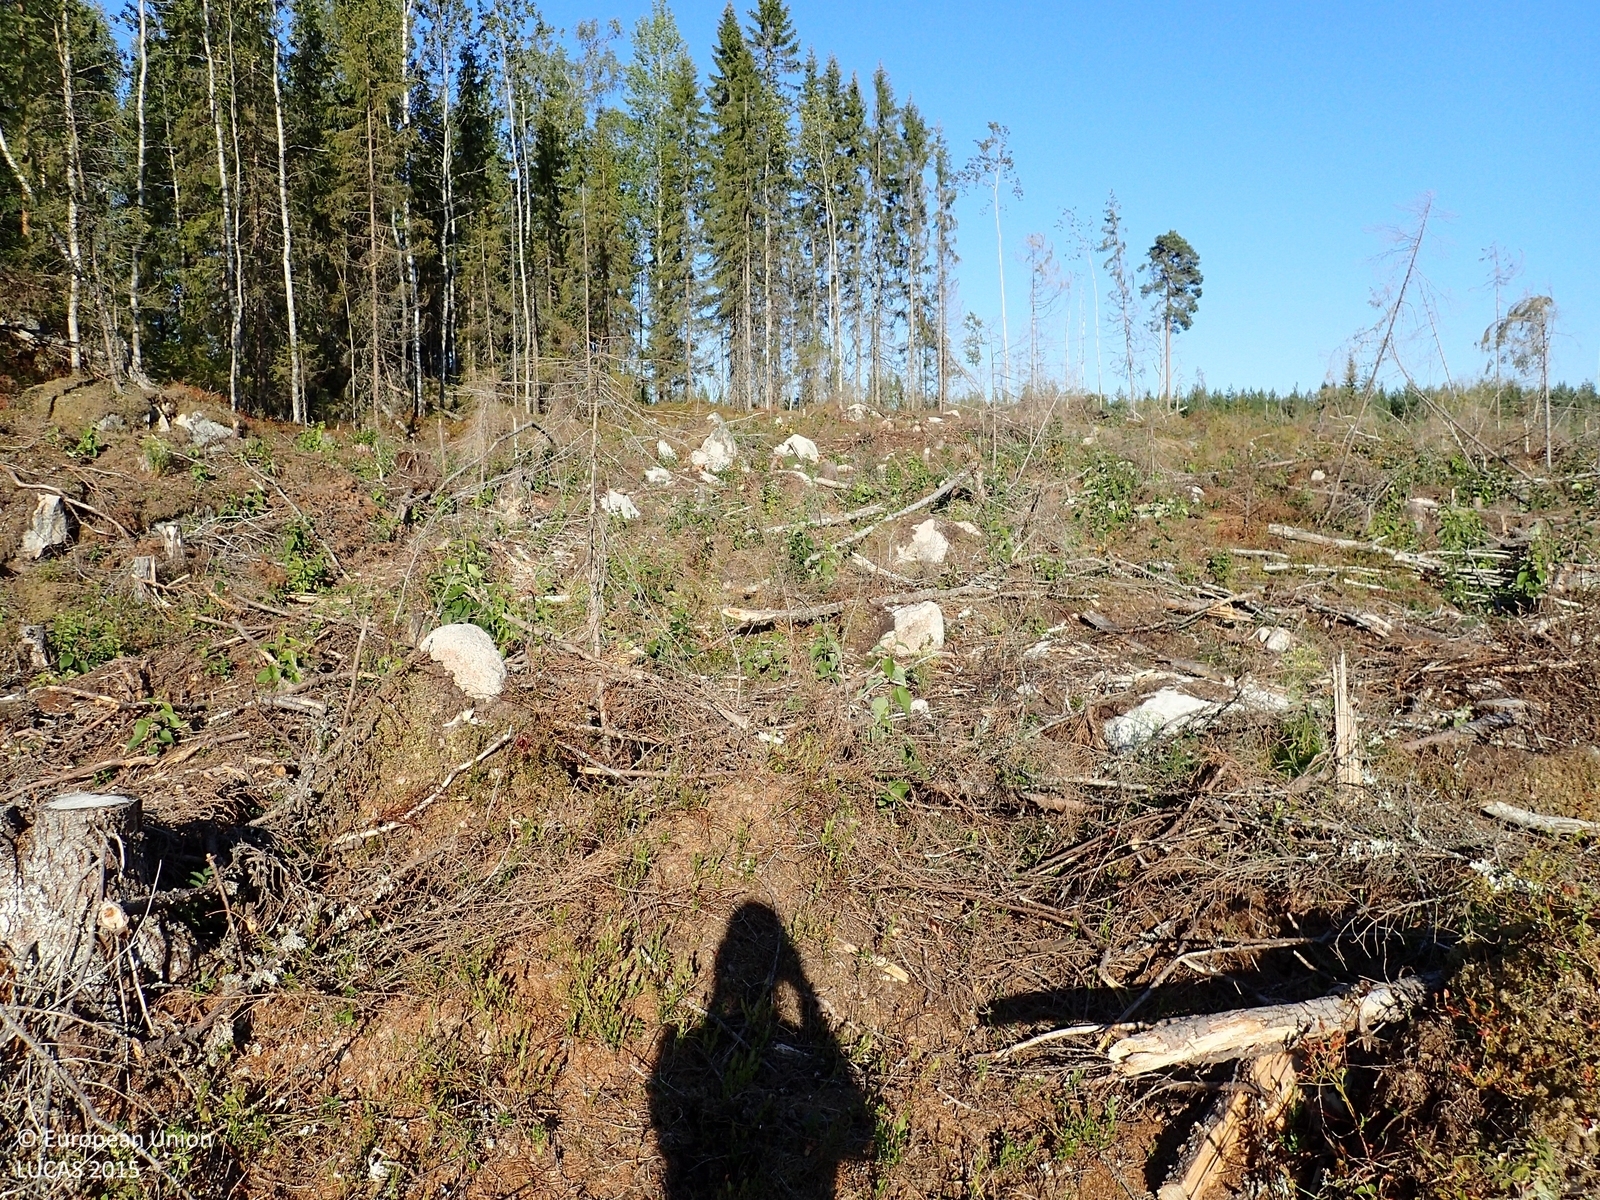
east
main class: Shrubland
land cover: Shrubland with sparse tree cover
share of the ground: 10 - 25 %
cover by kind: unconsolidated bare surface 40 %, lichens and mosses 20 %, shrubs 15 %, herbaceous plants 15 %, coniferous forest trees 5 %, consolidated bare surface 5 %
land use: Forestry
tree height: < 5 m
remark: Clear cut
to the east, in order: Shrubland with sparse tree cover; Spruce dominated coniferous woodland; Broadleaved woodland; Pine dominated mixed woodland; Grassland with sparse tree/shrub cover; Pine dominated coniferous woodland
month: August
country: FI
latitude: 62.4324
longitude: 21.8826
